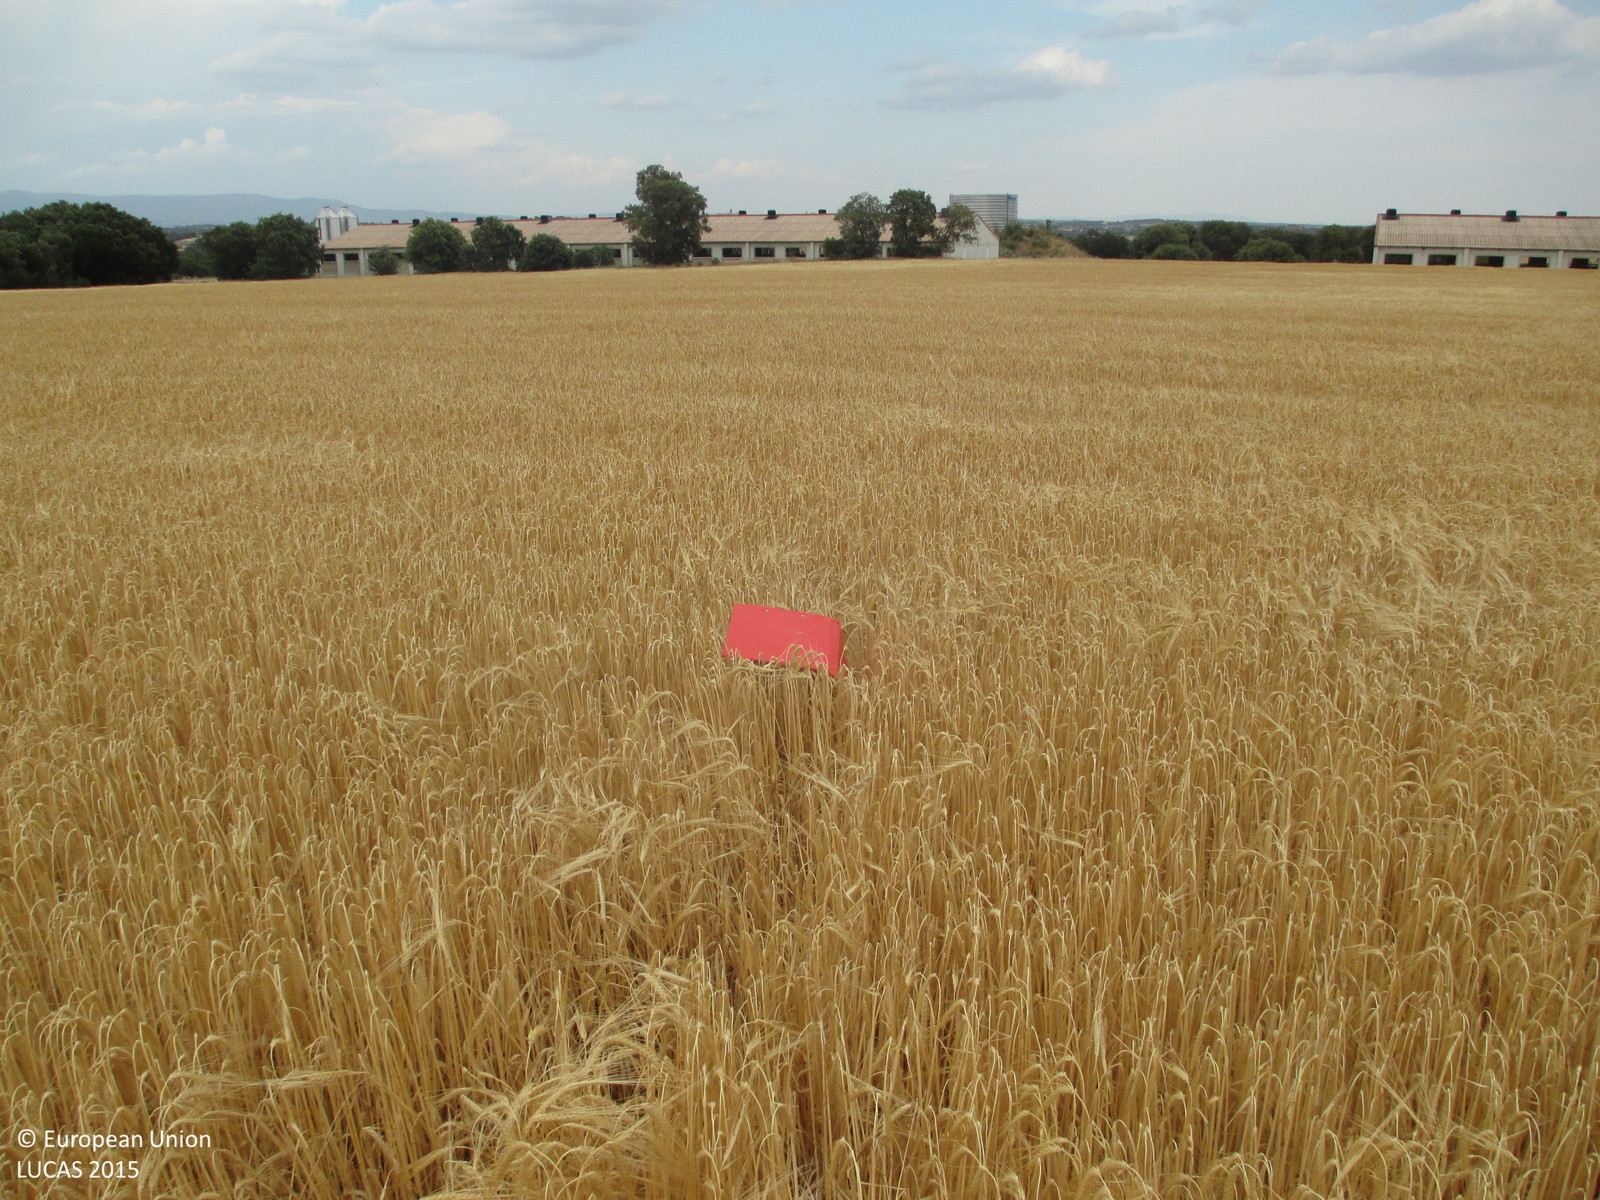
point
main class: Cropland
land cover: Barley
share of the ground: > 75 %
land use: Agriculture (excluding fallow land and kitchen gardens)
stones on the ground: < 10 %
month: May
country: ES
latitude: 42.1000
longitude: -0.2142
